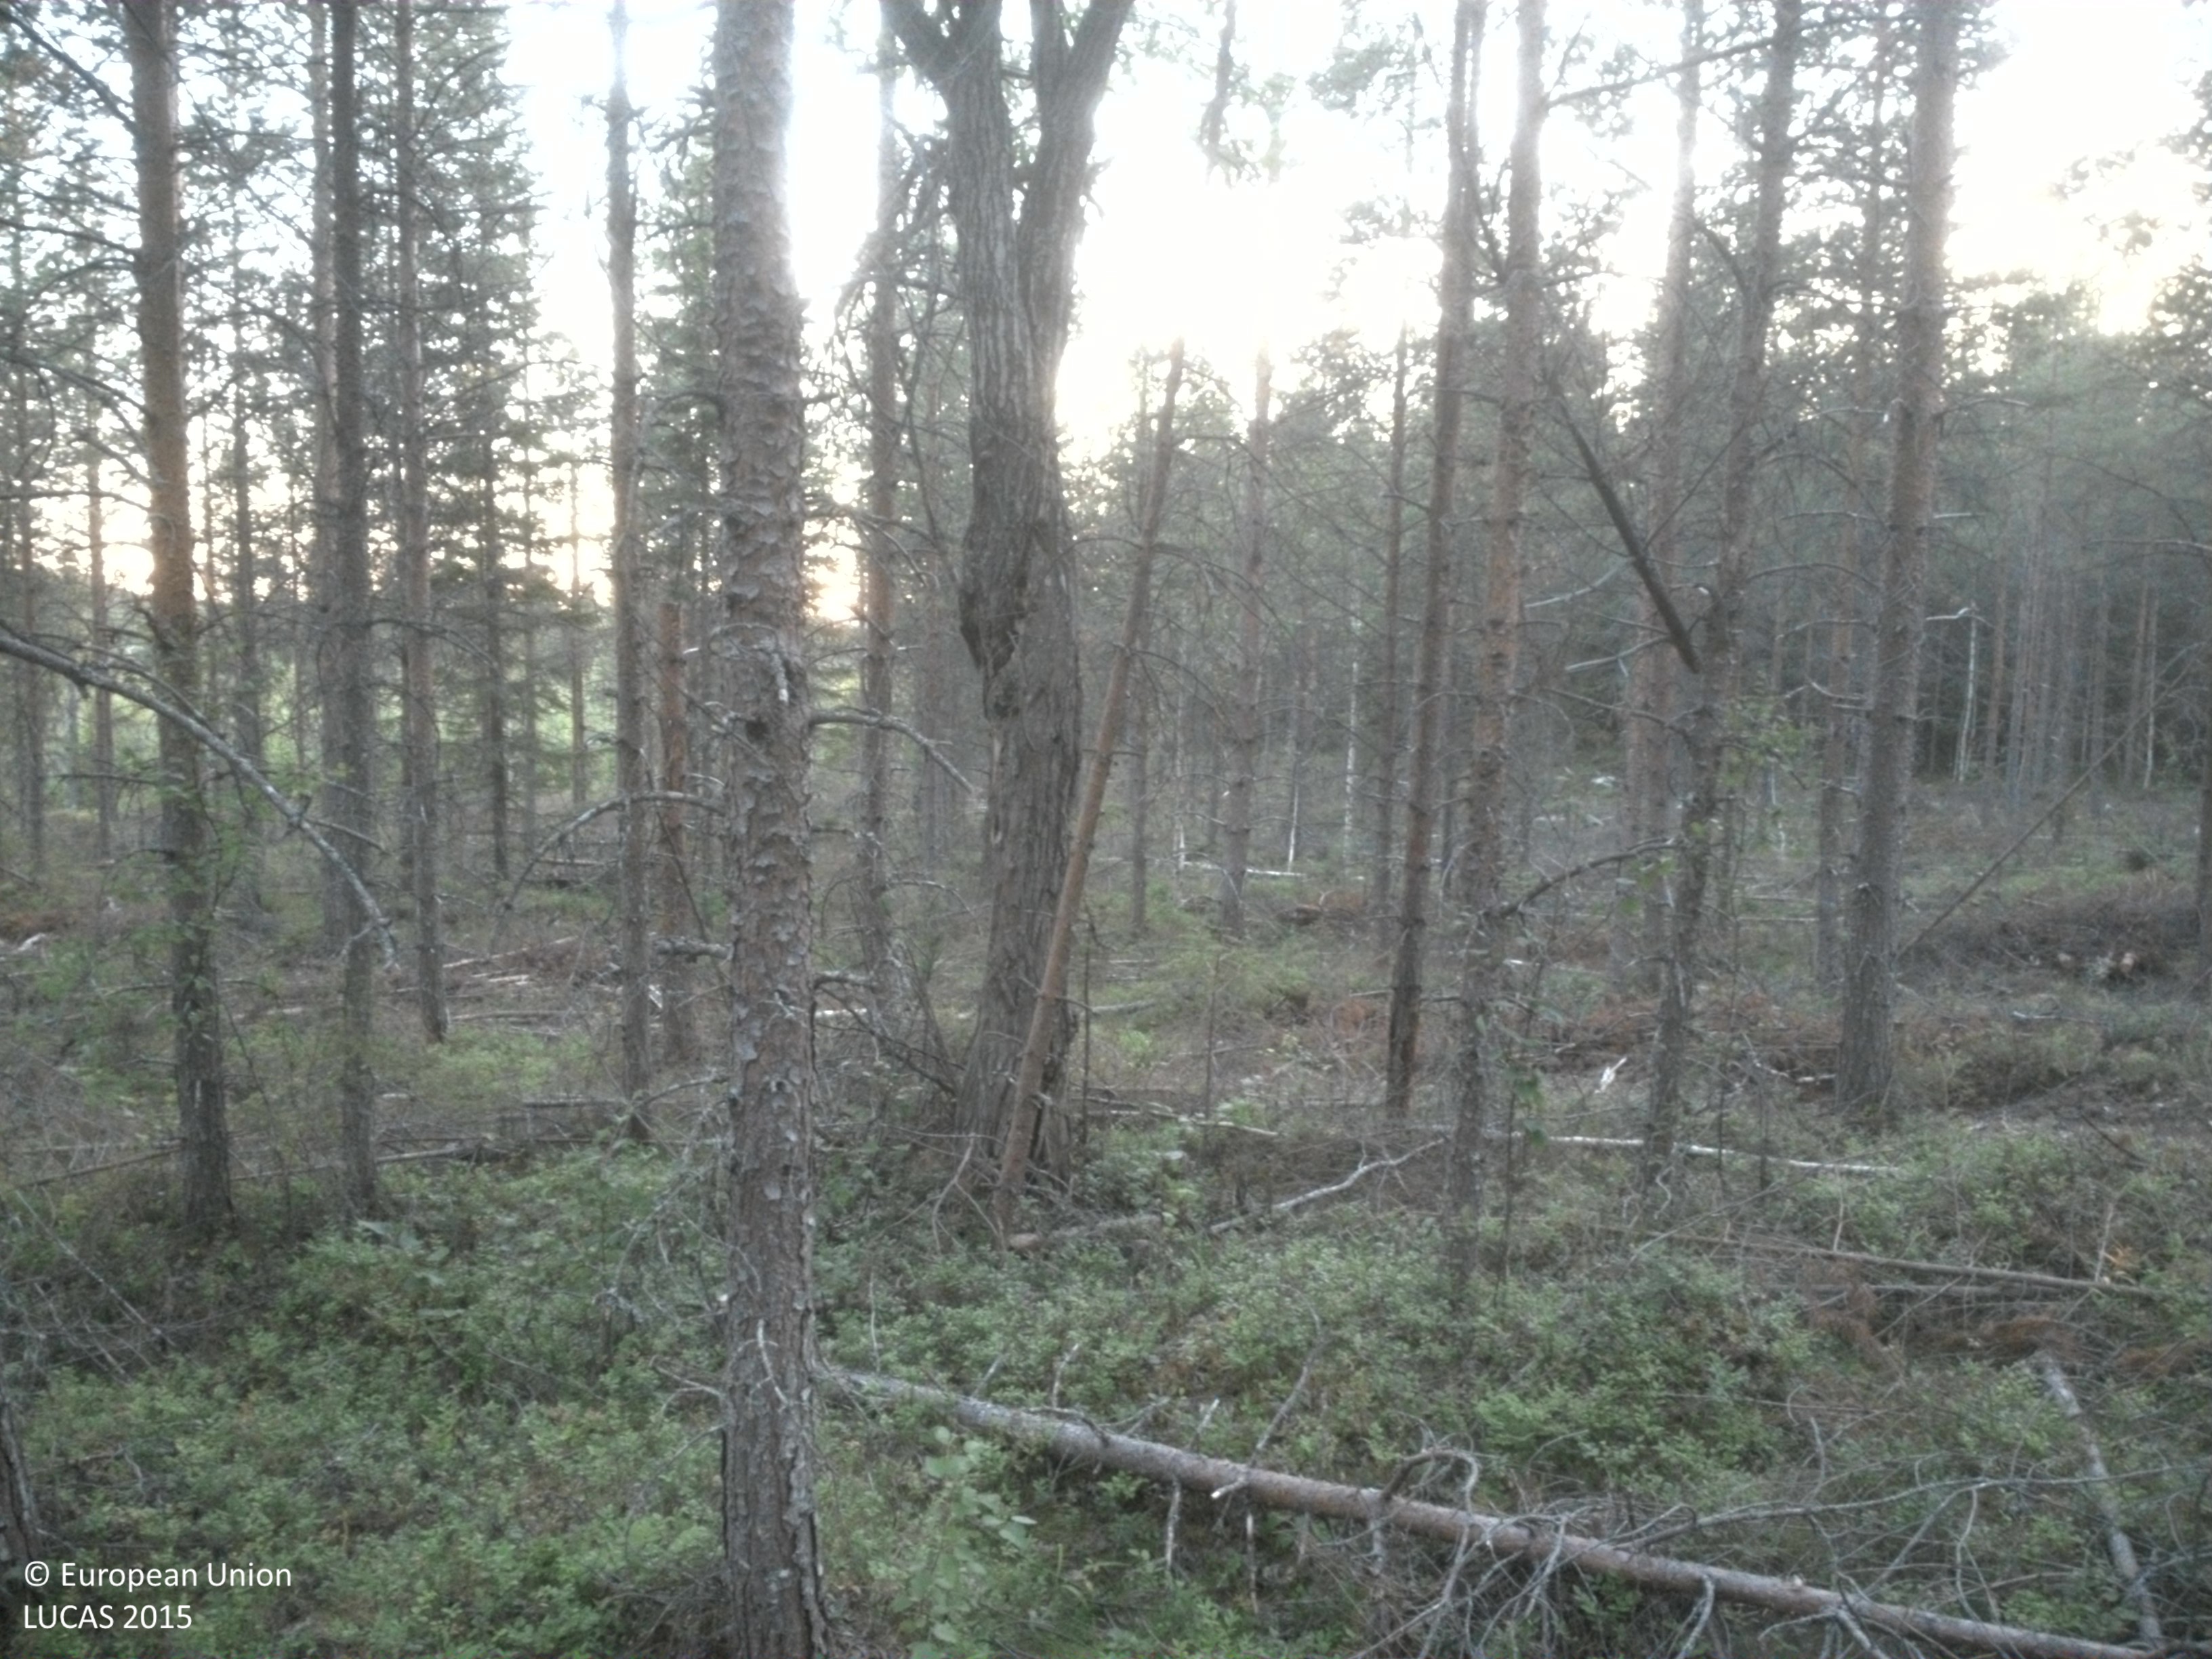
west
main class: Woodland
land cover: Pine dominated coniferous woodland
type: boreal forest
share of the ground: 50 - 75 %
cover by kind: coniferous forest trees 60 %, shrubs 30 %, herbaceous plants 5 %, lichens and mosses 5 %
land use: Forestry
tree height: > 5 m
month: August
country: SE
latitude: 64.6078
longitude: 18.4741
